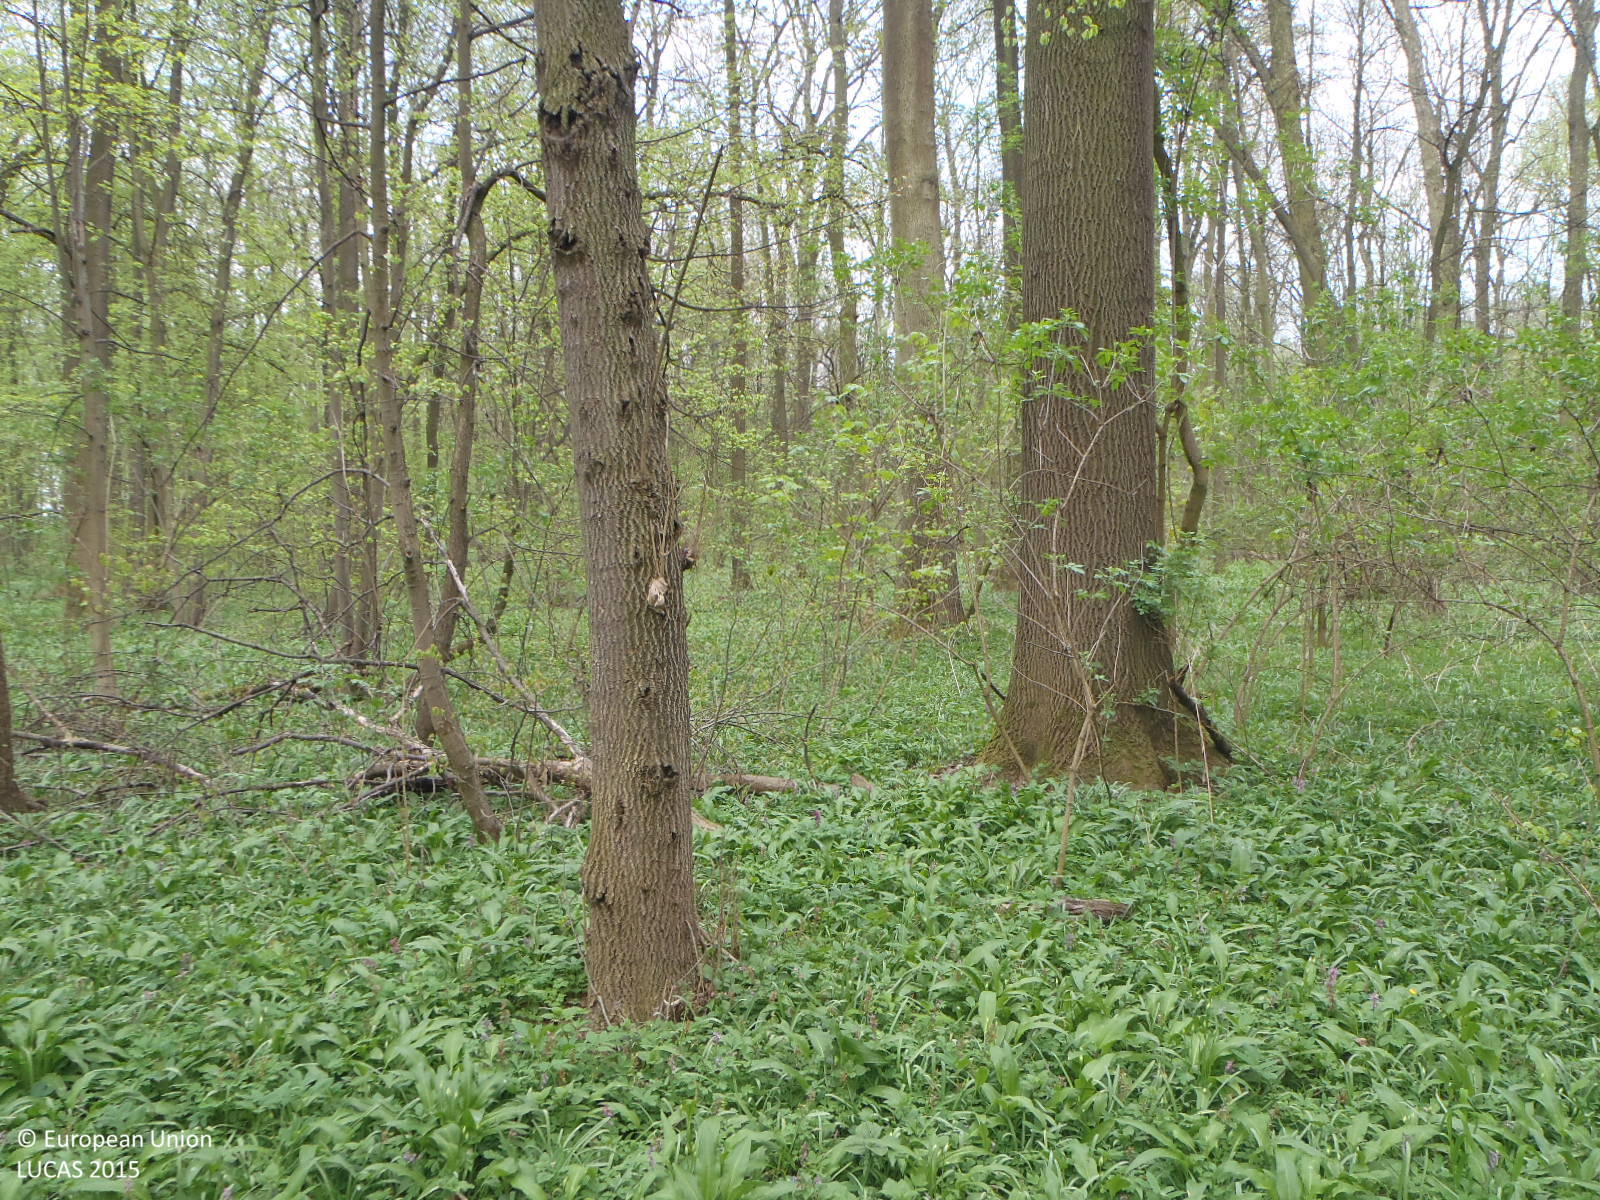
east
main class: Woodland
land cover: Broadleaved woodland
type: mesophytic deciduous forest
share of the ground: > 75 %
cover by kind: broadleaved forest trees 95 %, herbaceous plants 5 %
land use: Forestry
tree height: > 5 m
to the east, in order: Broadleaved woodland; Tracks; Broadleaved woodland; Ditches and canals; Broadleaved woodland
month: April
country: CZ
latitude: 49.7103
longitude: 17.0964
